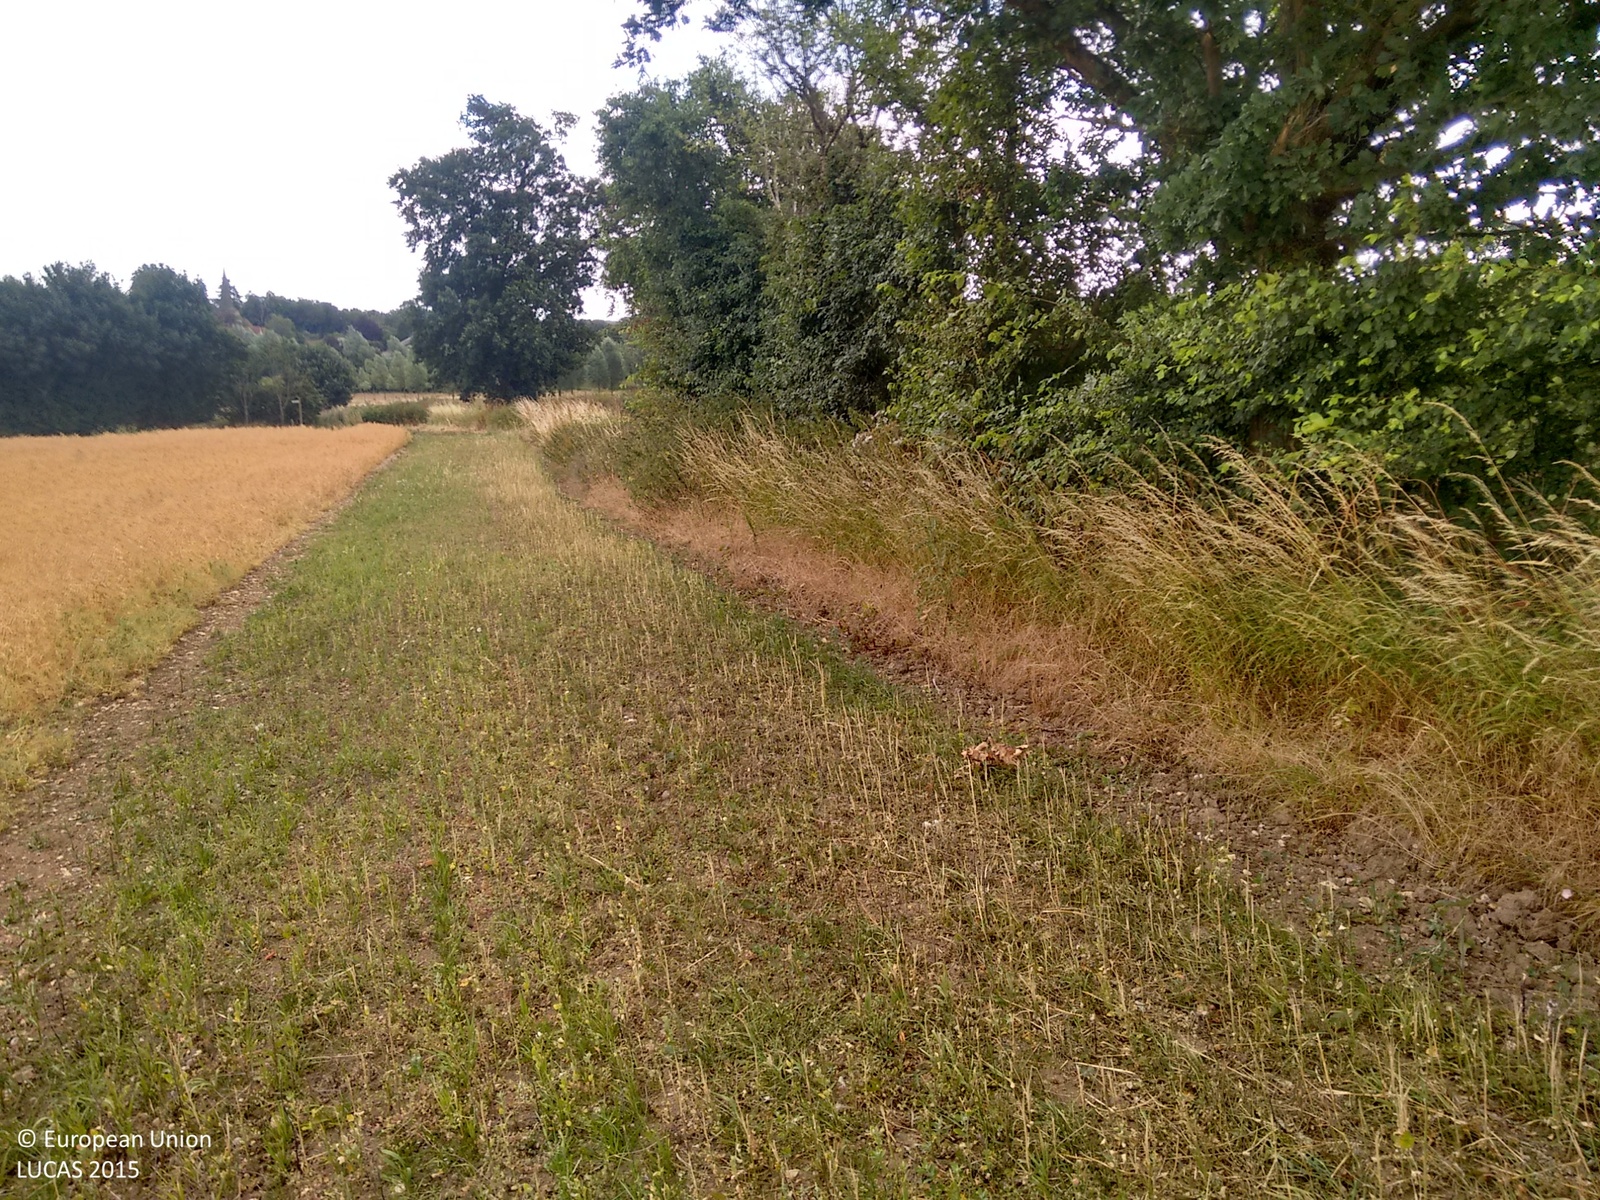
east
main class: Grassland
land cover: Spontaneously vegetated surfaces
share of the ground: 25 - 50 %
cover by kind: herbaceous plants 100 %
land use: Fallow land
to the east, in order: Spontaneously vegetated surfaces; Grass margins; Paved roads, cycling and walking lanes; Grass margins; Managed hedges; Grass margins; Tracks; Grass margins; Rape and turnip rape; Grass margins; Grassland with sparse tree/shrub cover; Tracks; Grassland with sparse tree/shrub cover
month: July
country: GB
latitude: 51.8193
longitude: 0.5575
